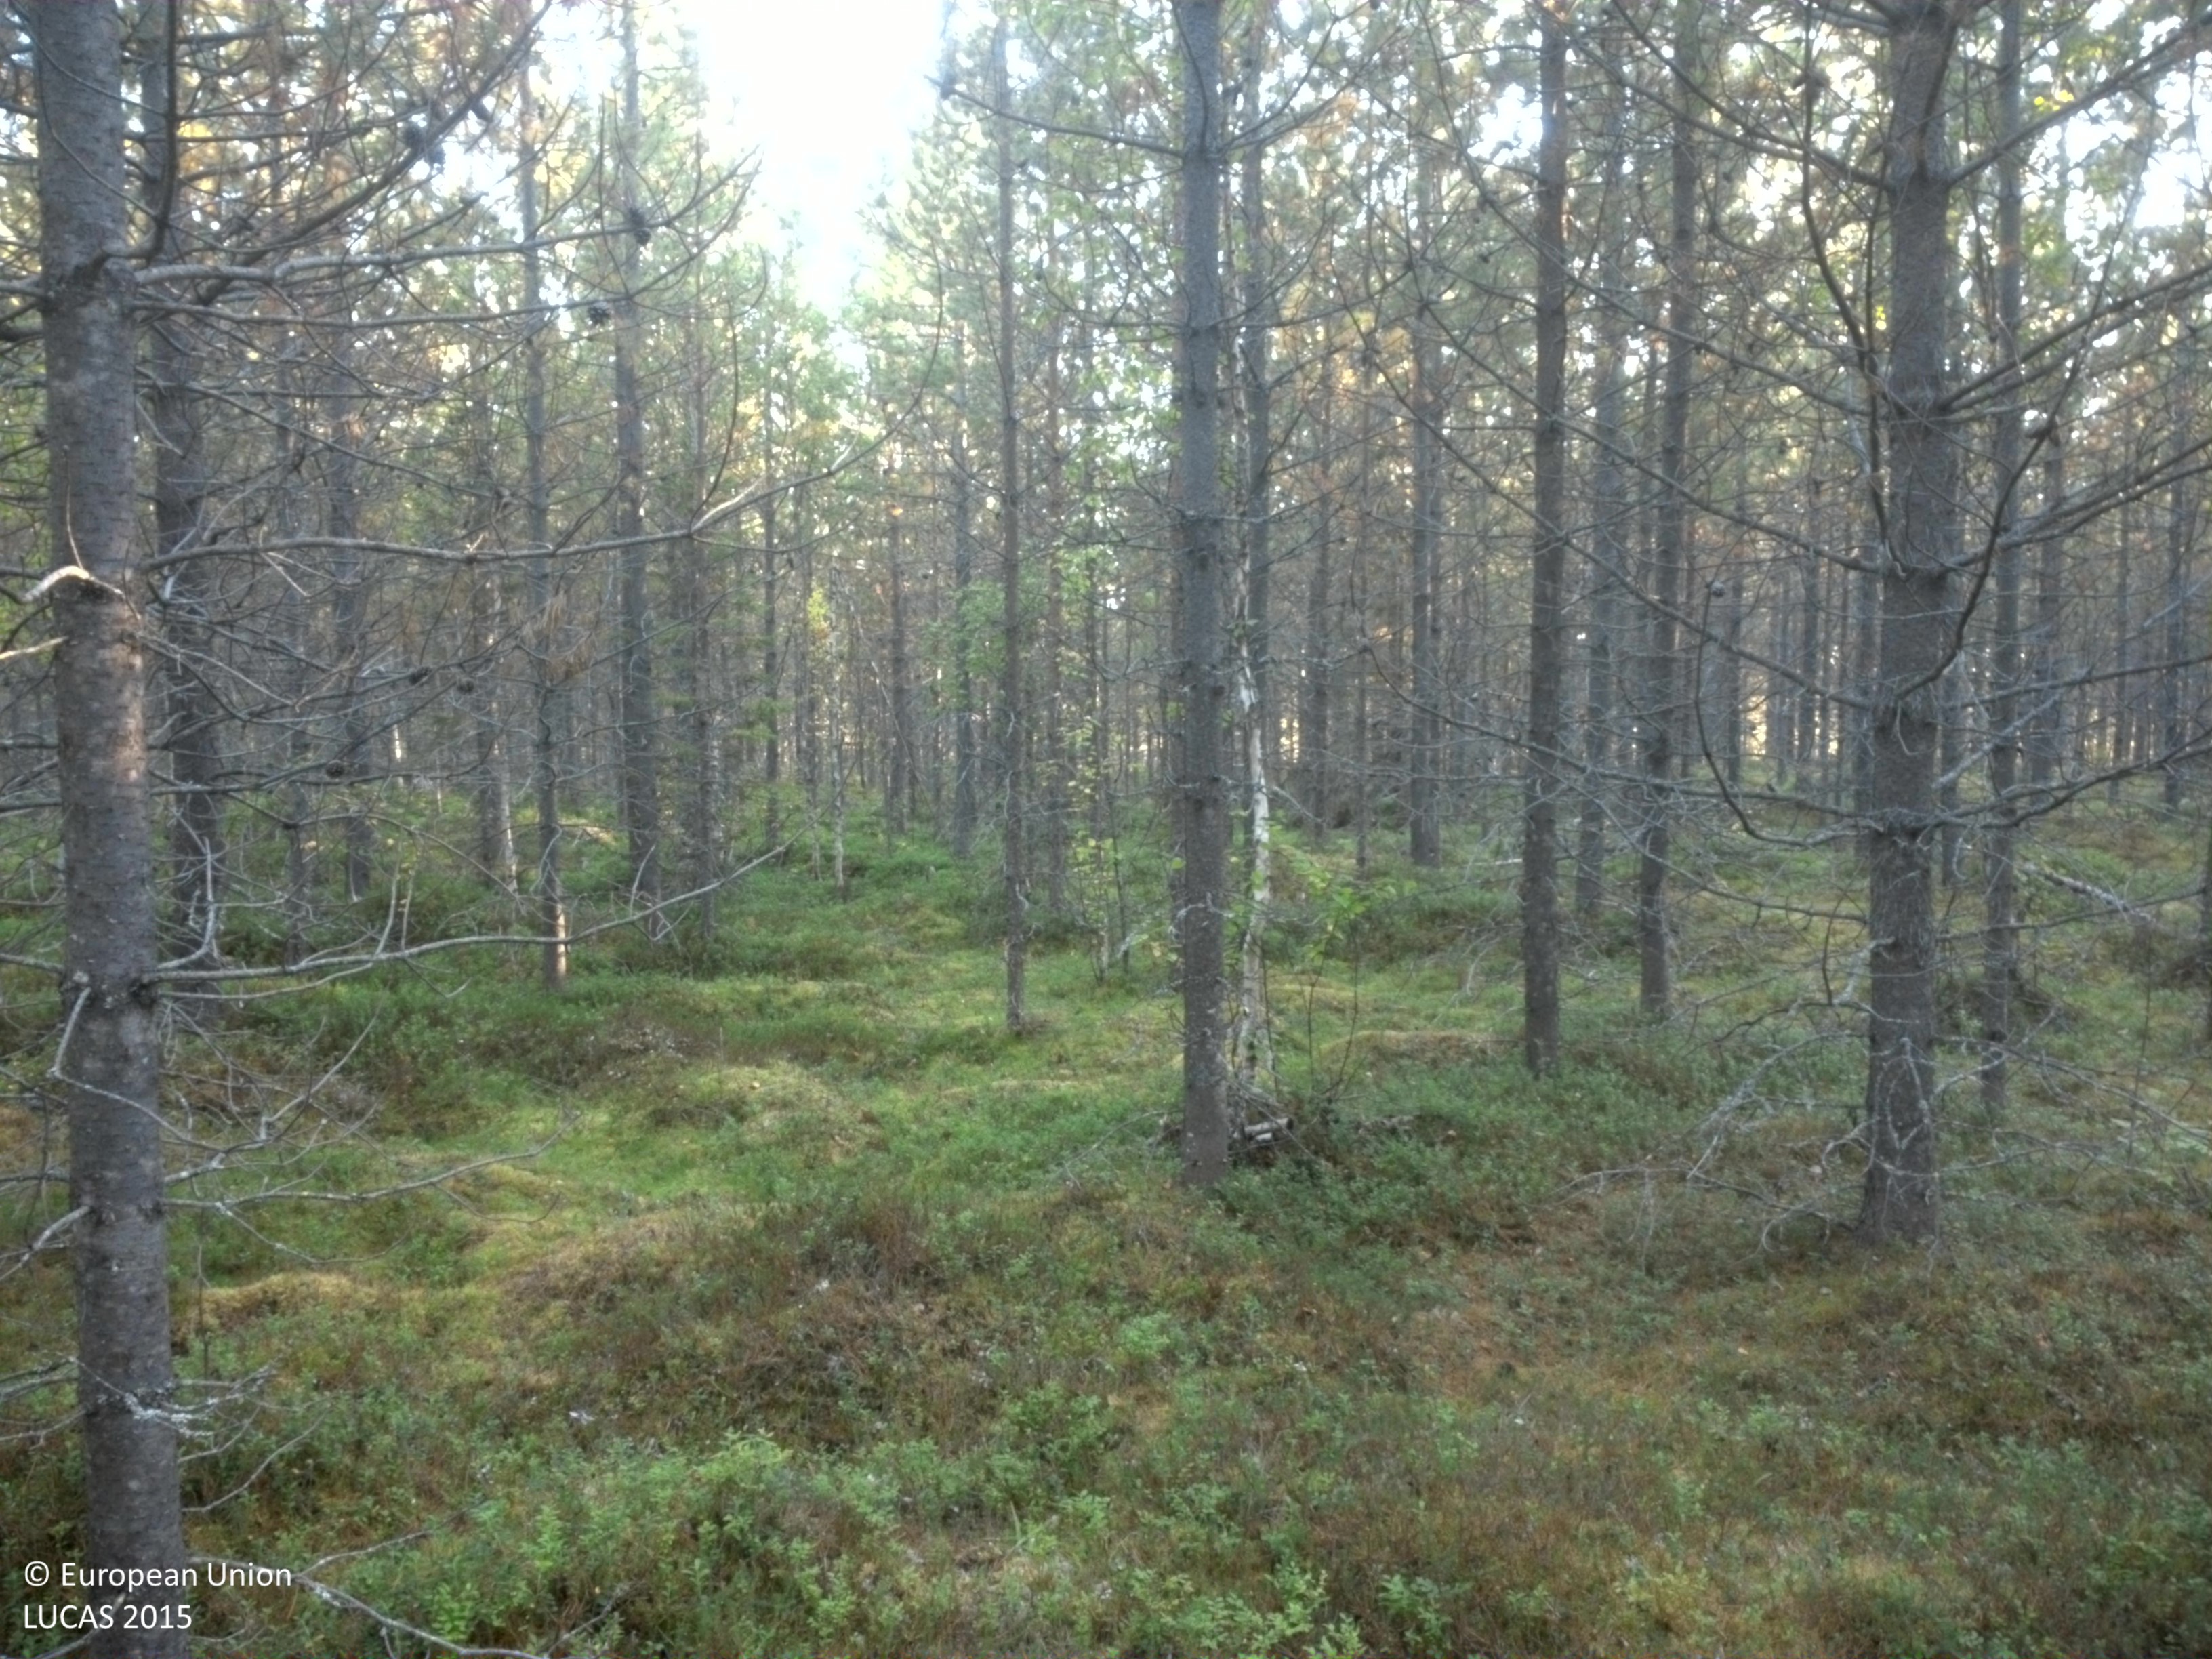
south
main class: Woodland
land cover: Pine dominated coniferous woodland
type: exotic forest
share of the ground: > 75 %
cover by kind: coniferous forest trees 70 %, lichens and mosses 15 %, shrubs 10 %, broadleaved forest trees 5 %
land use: Forestry
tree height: > 5 m
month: September
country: SE
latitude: 64.6931
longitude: 19.8467
